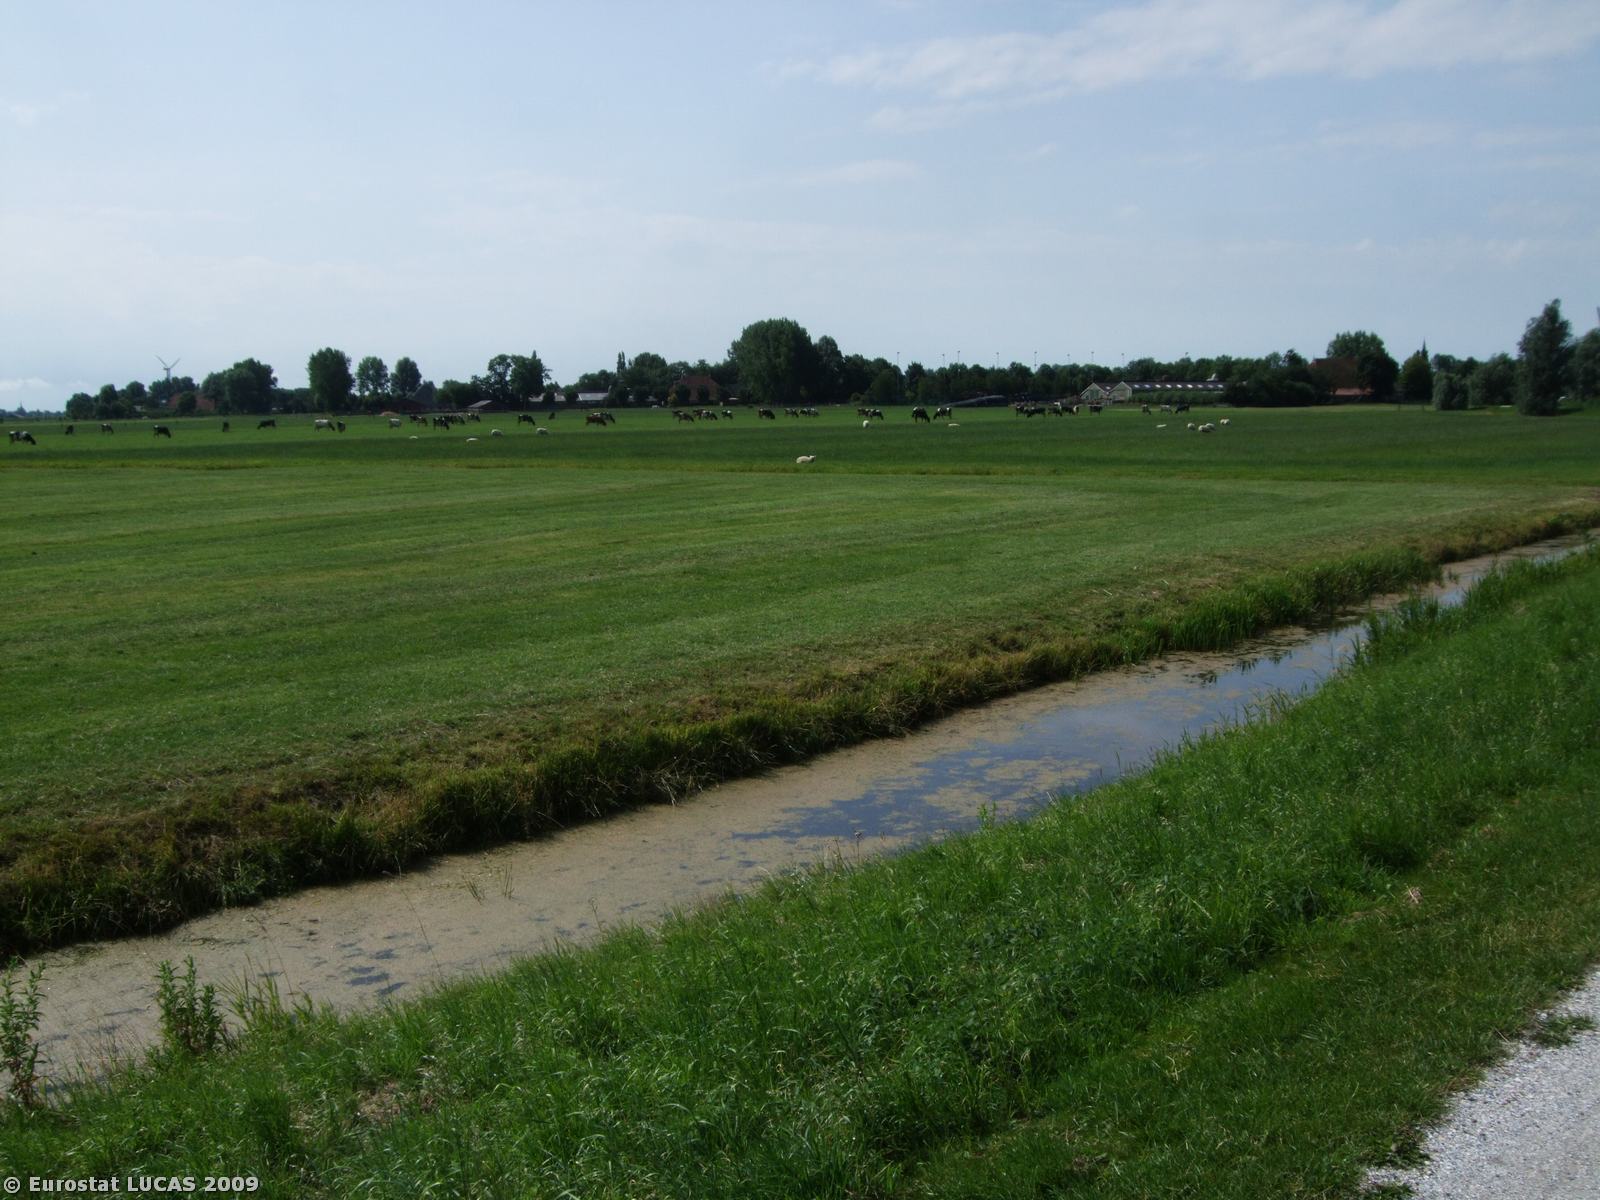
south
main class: Wetlands
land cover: Inland marshes
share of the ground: > 75 %
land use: Unused
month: May
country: NL
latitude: 53.0172
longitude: 5.6313
